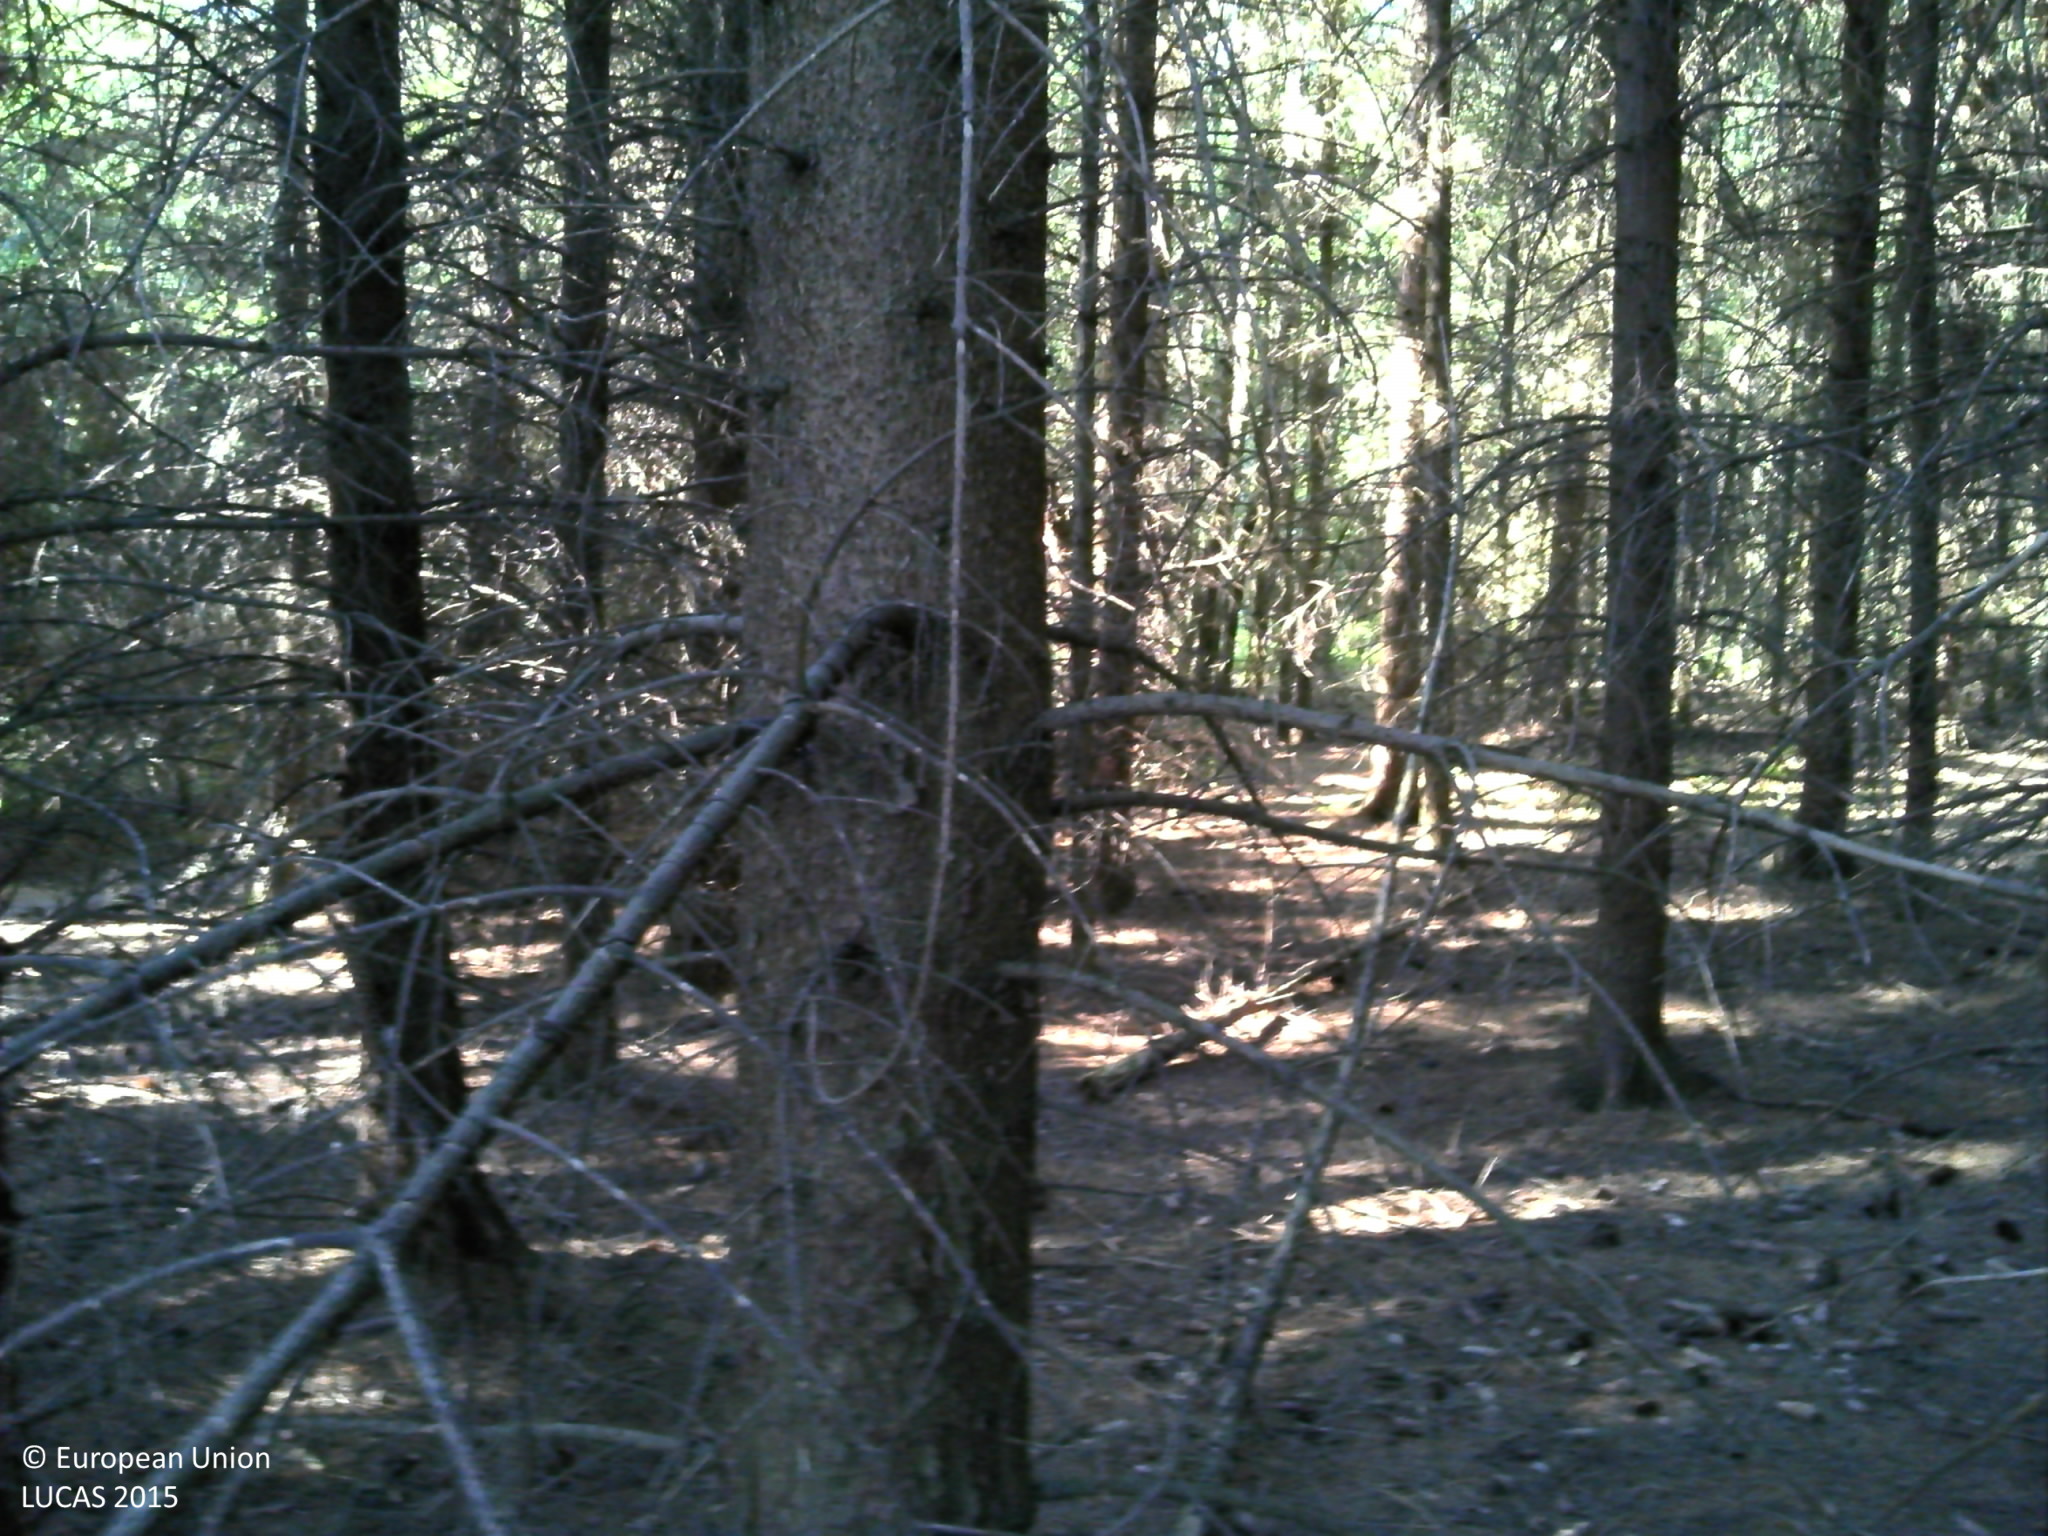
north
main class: Woodland
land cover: Spruce dominated coniferous woodland
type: exotic forest
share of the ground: > 75 %
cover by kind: coniferous forest trees 80 %, consolidated bare surface 15 %, lichens and mosses 5 %
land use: Forestry
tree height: > 5 m
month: July
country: FR
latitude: 49.8686
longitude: 4.4446
